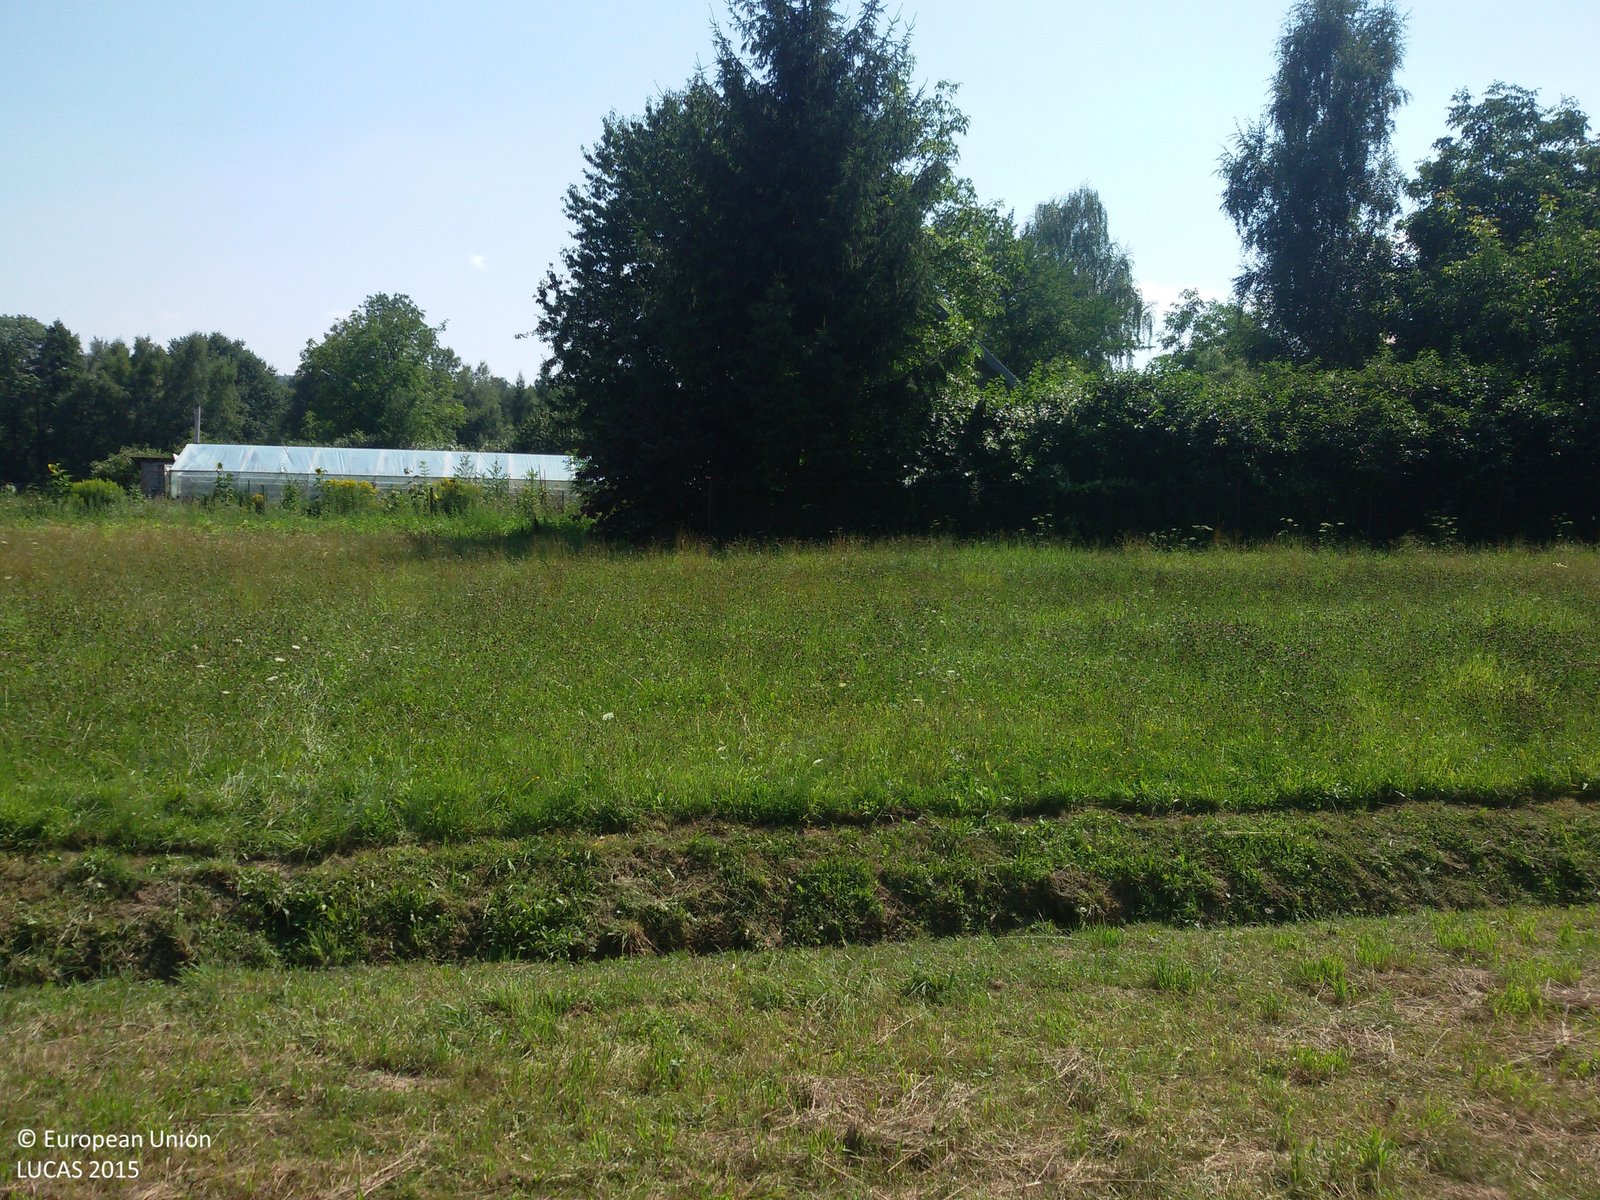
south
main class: Grassland
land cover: Grassland without tree/shrub cover
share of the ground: > 75 %
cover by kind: herbaceous plants 100 %
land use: Residential
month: August
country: PL
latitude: 49.9511
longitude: 20.7016
